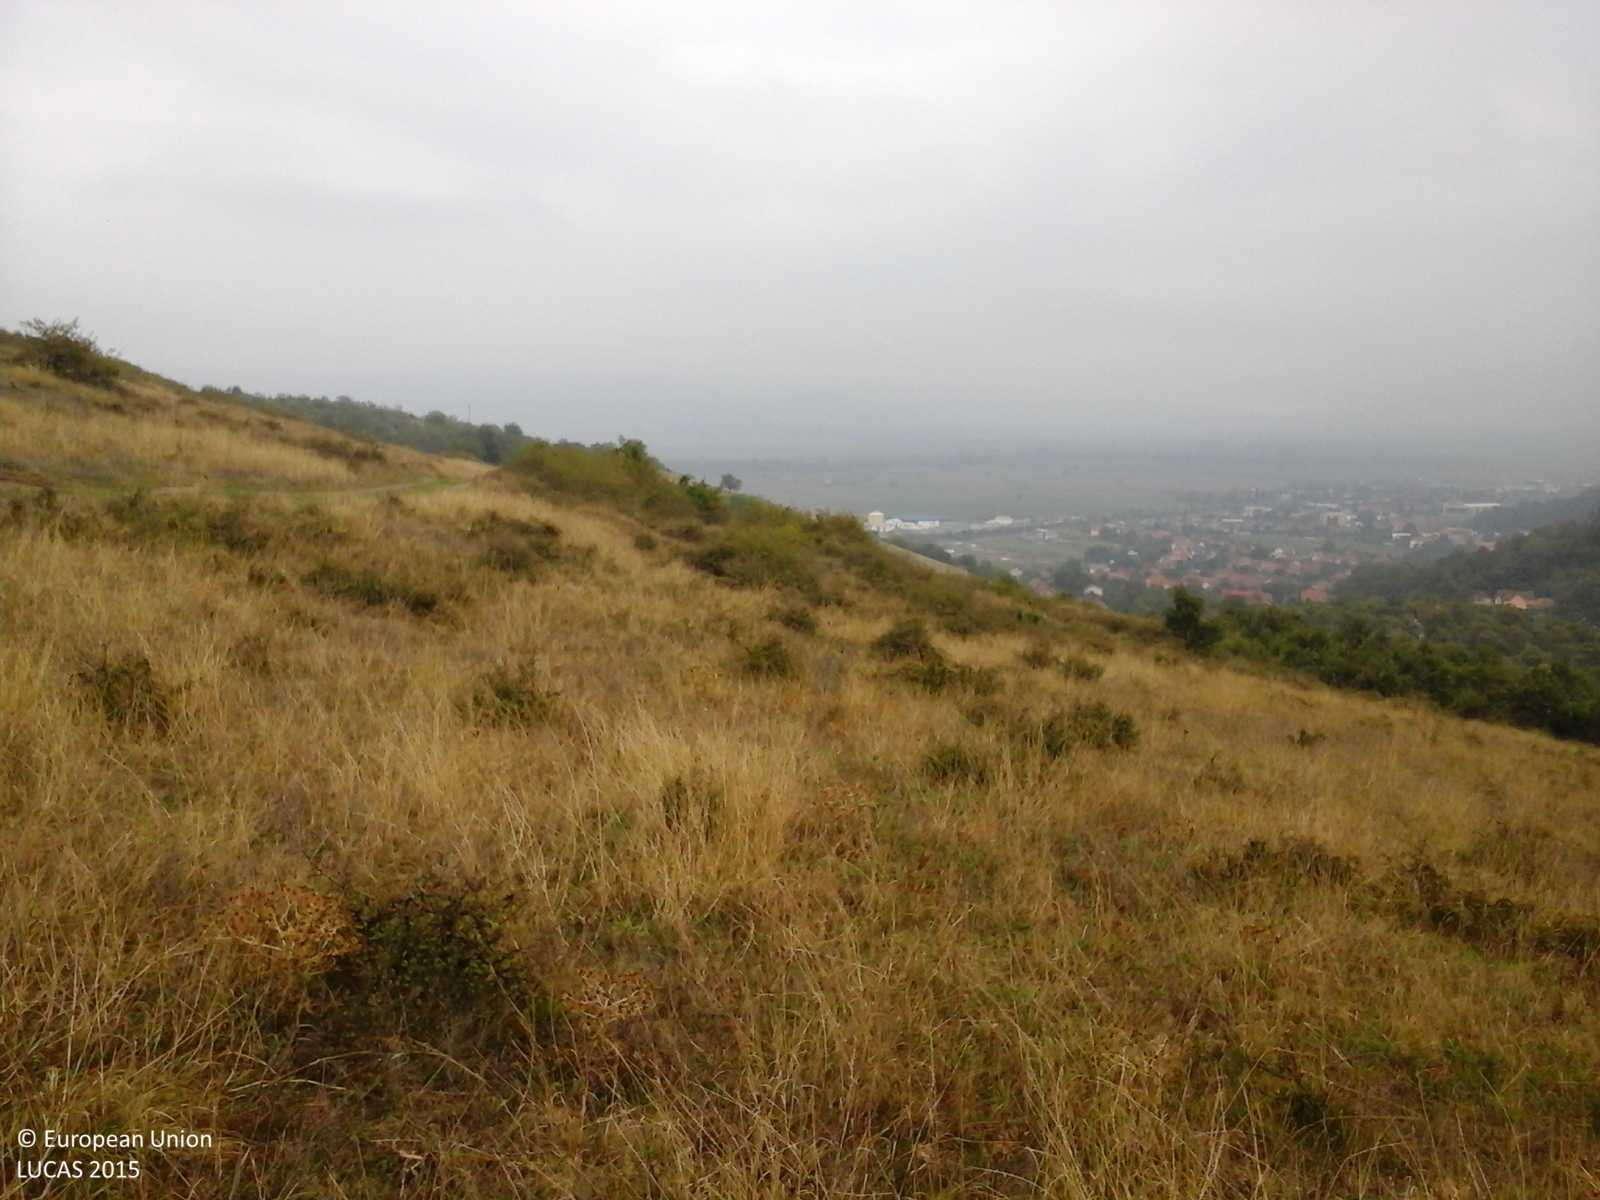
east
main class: Grassland
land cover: Grassland with sparse tree/shrub cover
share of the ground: > 75 %
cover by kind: herbaceous plants 85 %, shrubs 10 %, broadleaved forest trees 5 %
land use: Agriculture (excluding fallow land and kitchen gardens)
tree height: < 5 m
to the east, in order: Grassland with sparse tree/shrub cover; Shrubland without tree cover; Grassland with sparse tree/shrub cover; Shrubland without tree cover
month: September
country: RO
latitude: 45.8971
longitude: 22.8777
